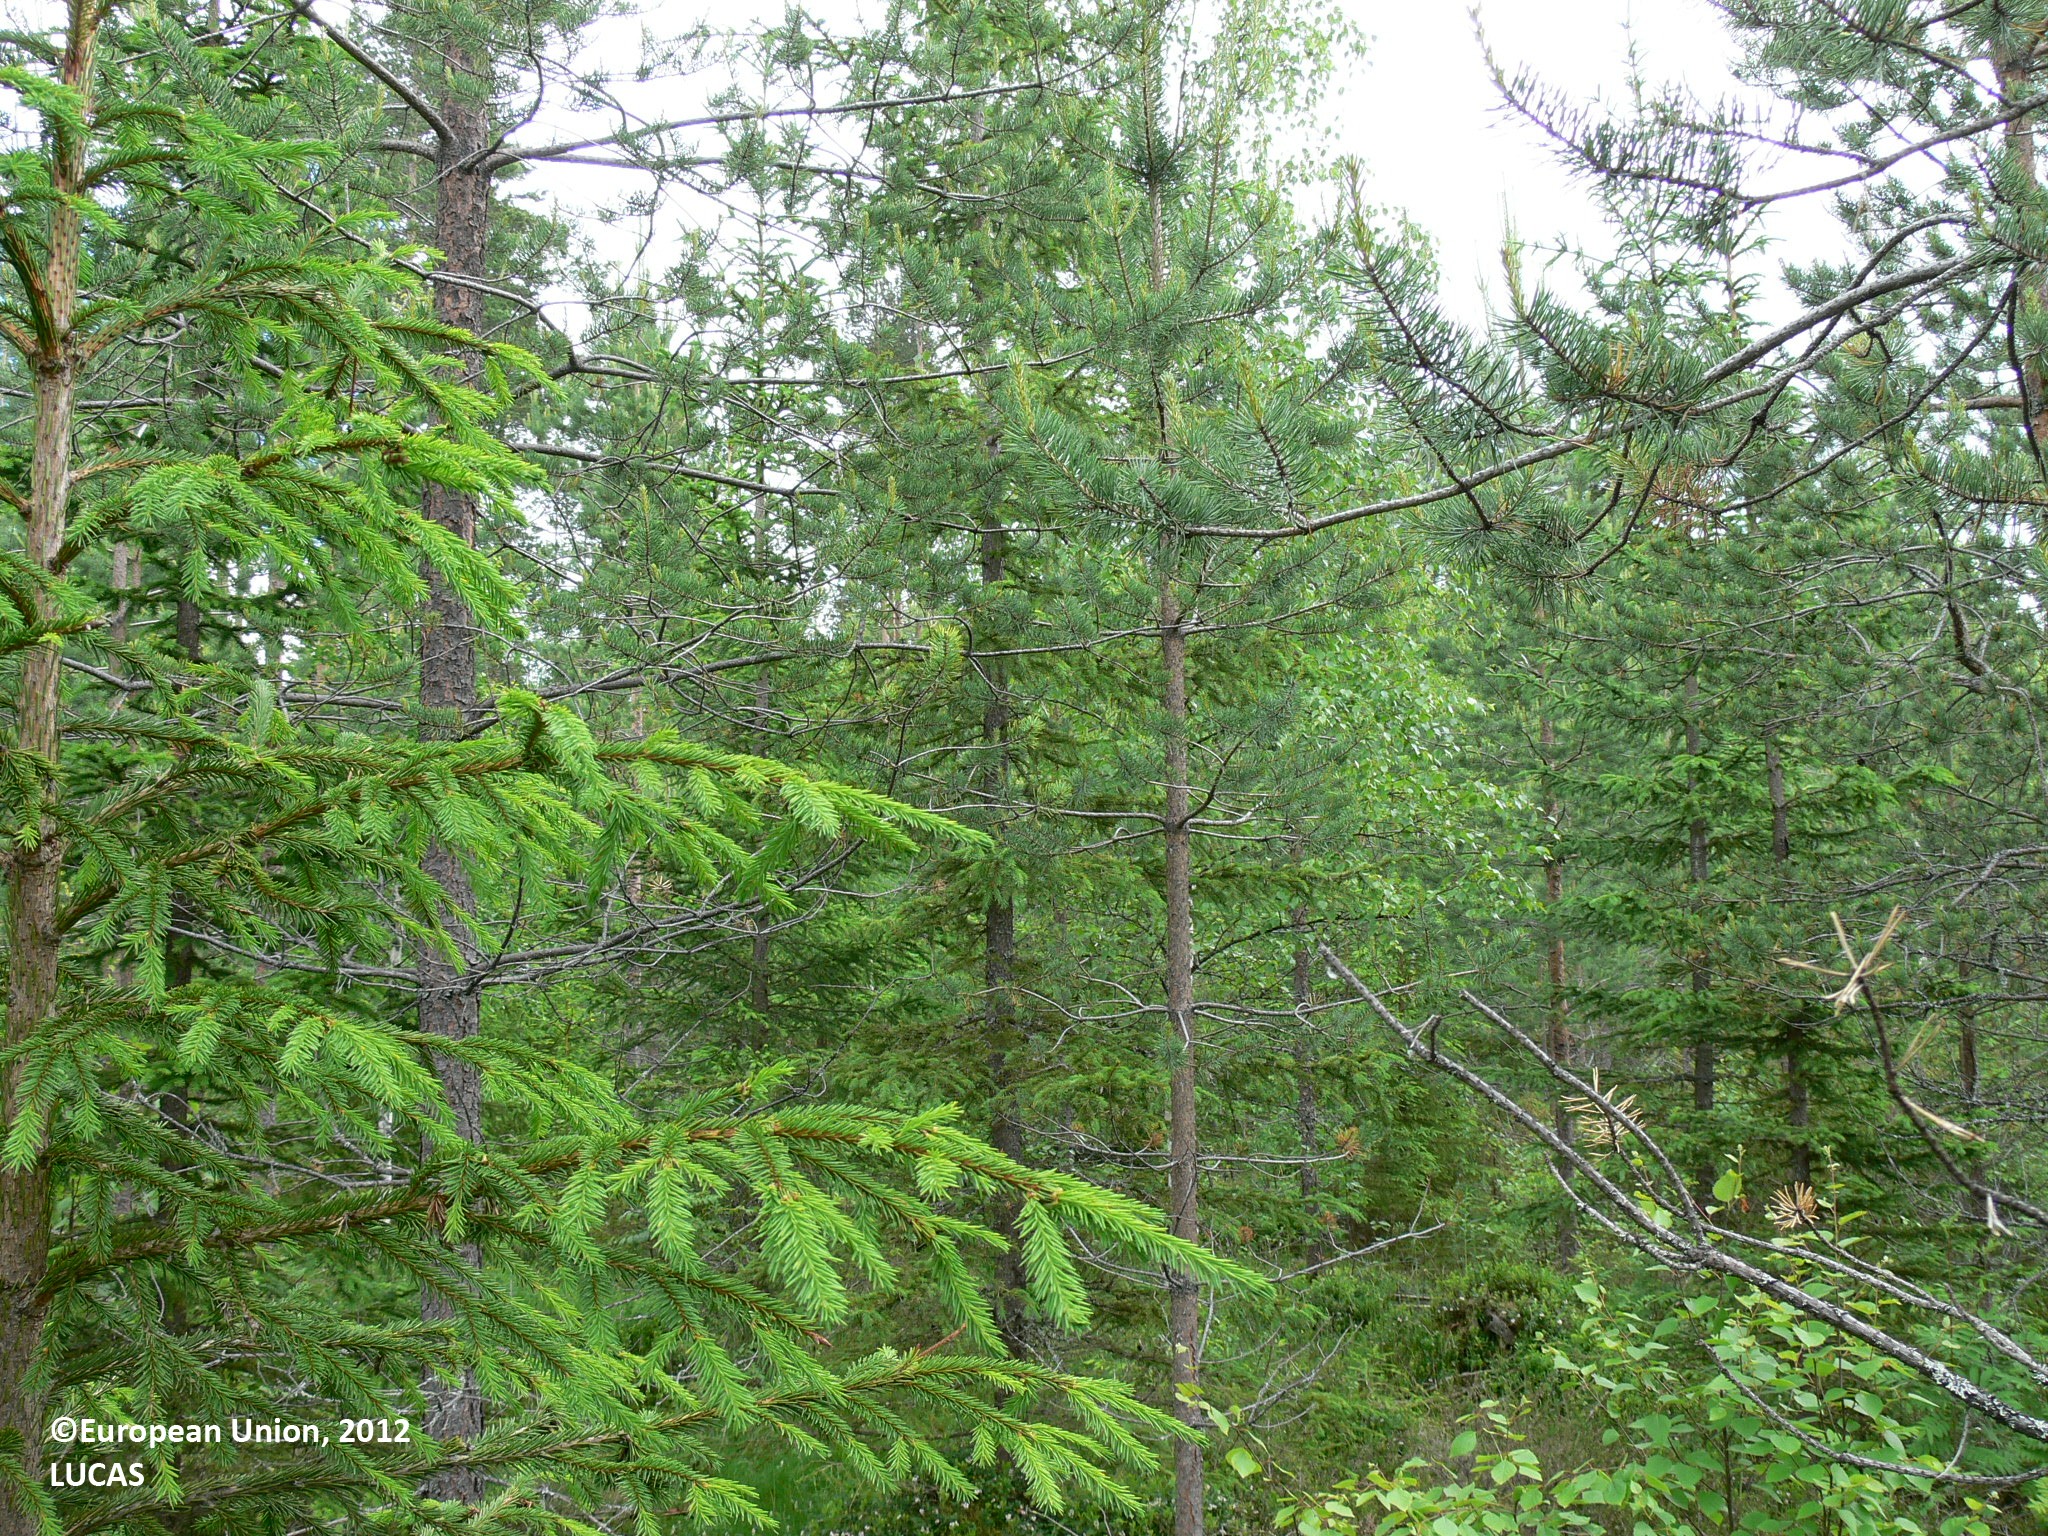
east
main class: Woodland
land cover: Other coniferous woodland
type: boreal forest
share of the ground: > 75 %
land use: Forestry
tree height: < 5 m
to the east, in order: Other coniferous woodland; Other mixed woodland; Ditches and canals; Other mixed woodland; Other coniferous woodland; Other mixed woodland; Spontaneously vegetated surfaces; Broadleaved woodland
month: June
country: FI
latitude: 62.7302
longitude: 30.6522
